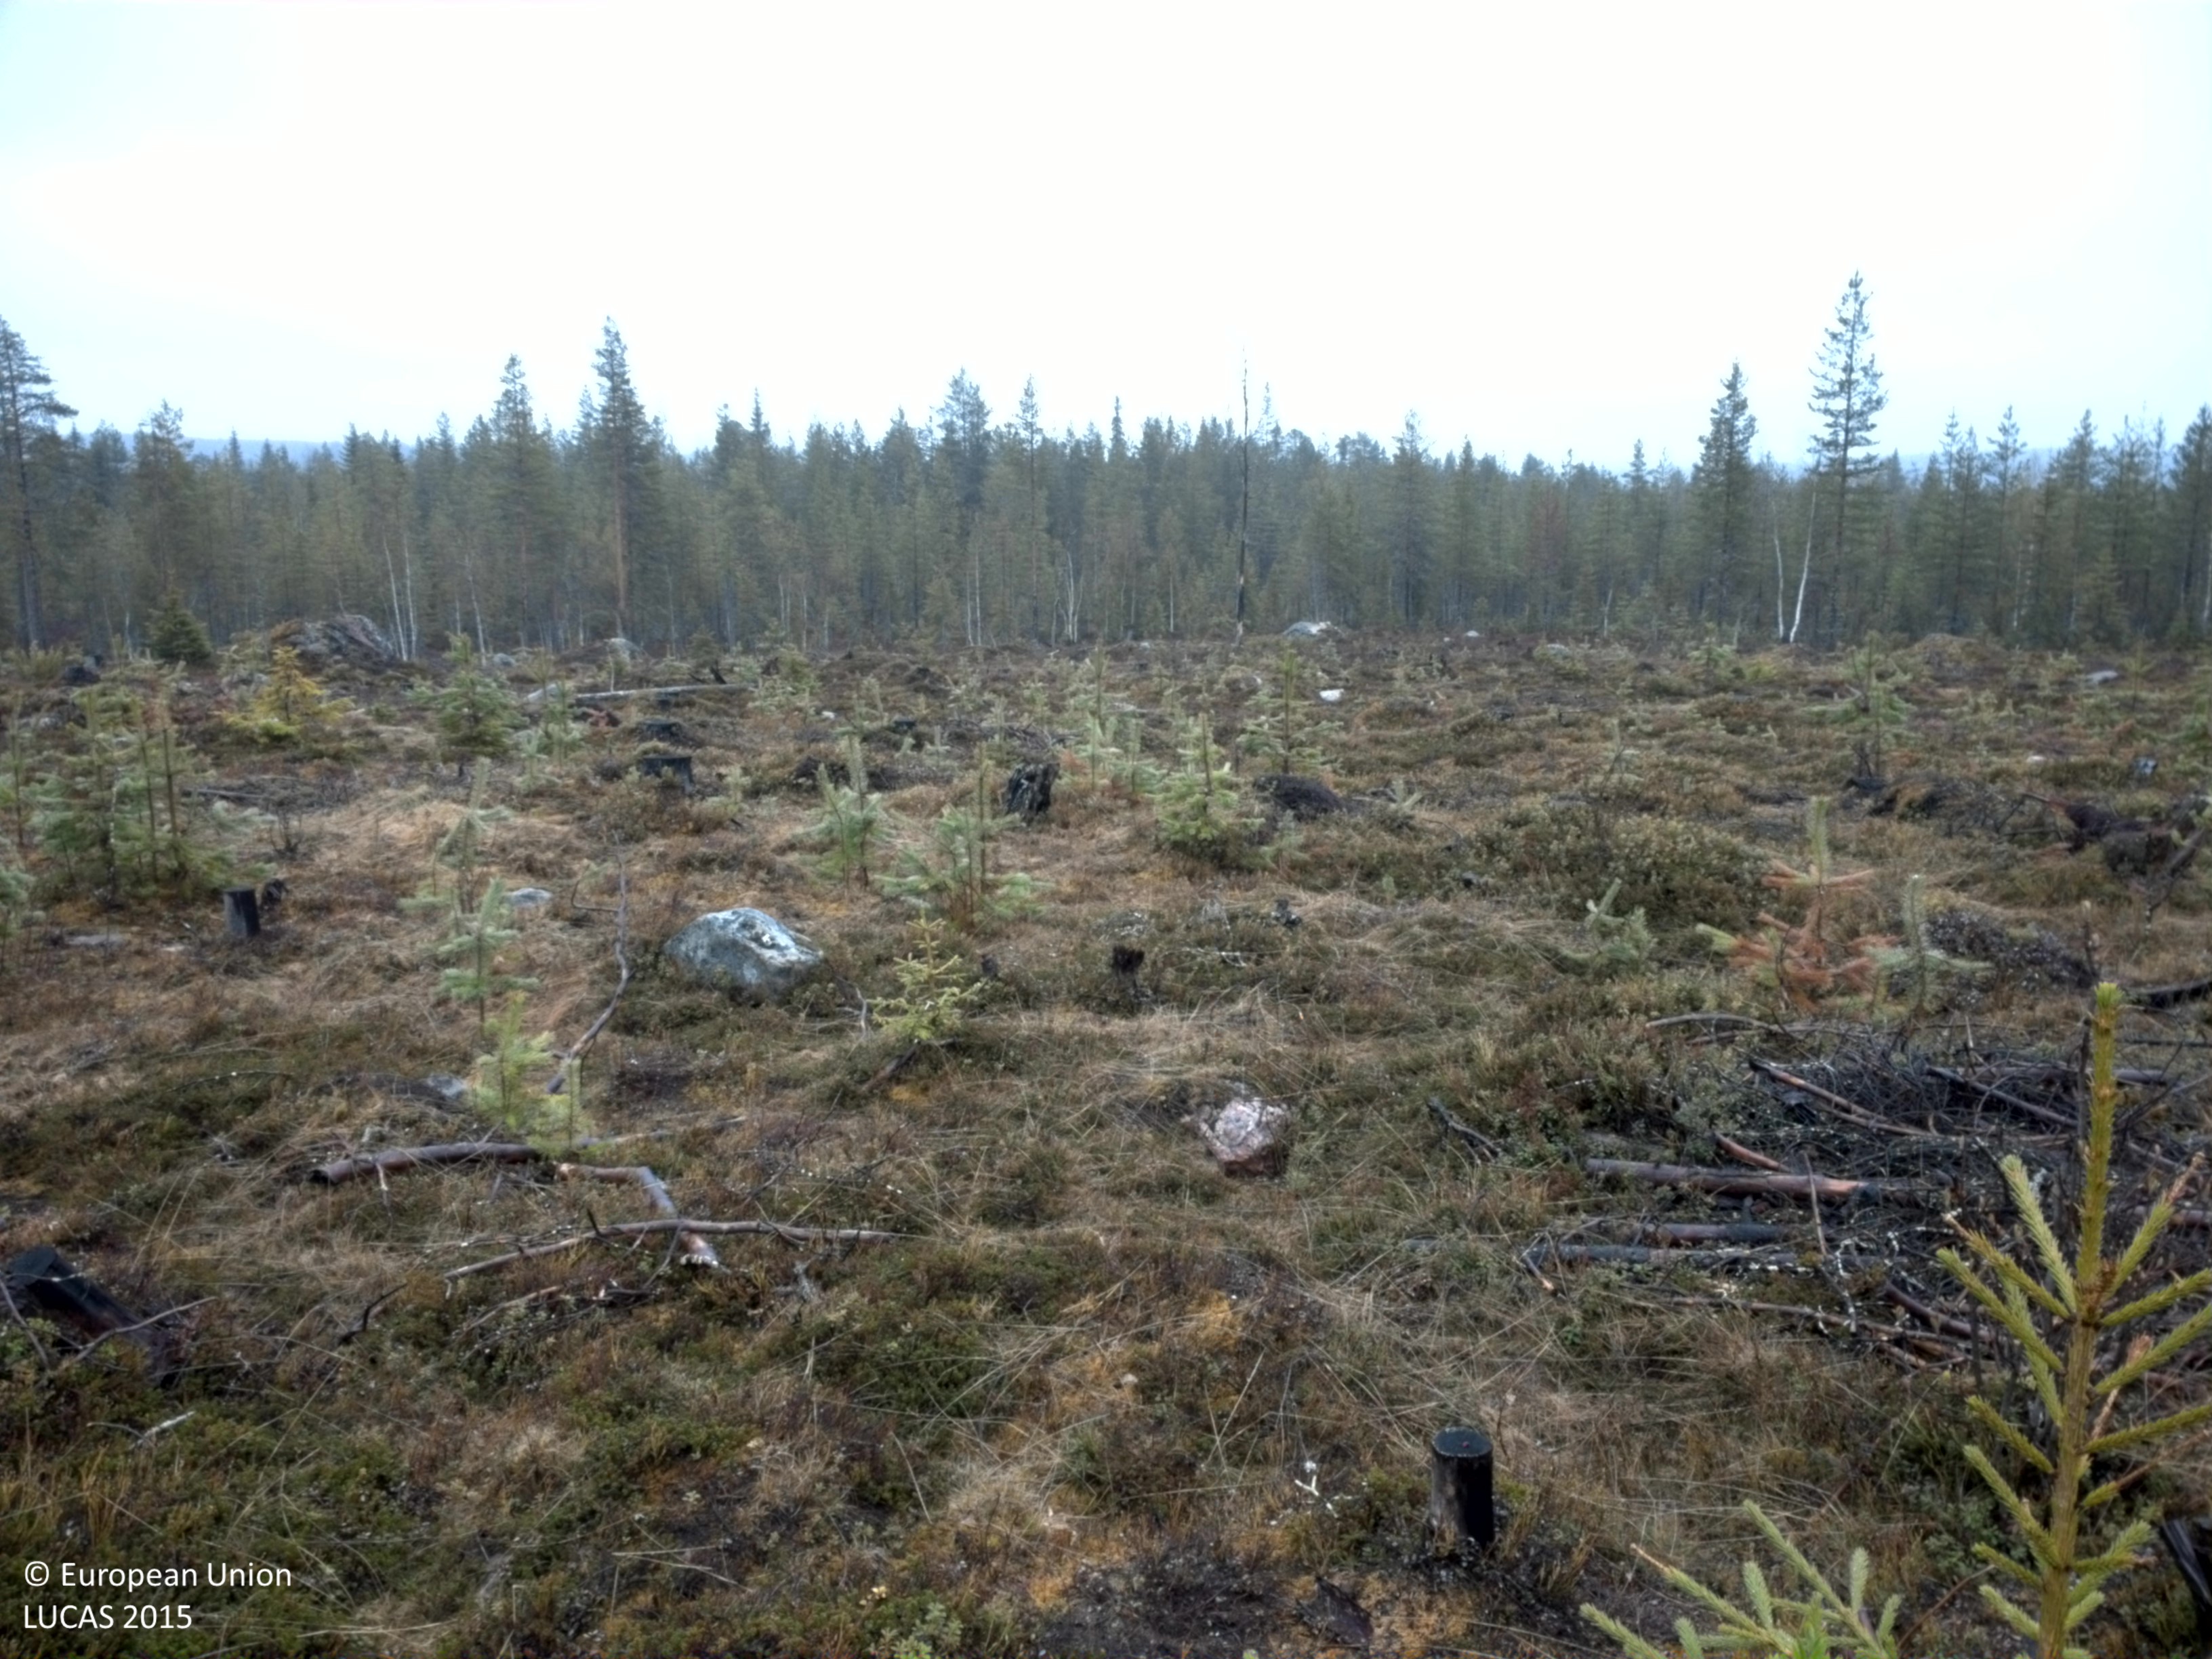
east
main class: Shrubland
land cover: Shrubland with sparse tree cover
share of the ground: > 75 %
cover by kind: shrubs 95 %, coniferous forest trees 5 %
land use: Forestry
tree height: < 5 m
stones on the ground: 10 - 25 %
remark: Clear cut
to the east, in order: Shrubland with sparse tree cover; Pine dominated coniferous woodland; Ditches and canals; Paved roads, cycling and walking lanes; Other coniferous woodland
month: May
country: SE
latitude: 66.2859
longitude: 23.2418
